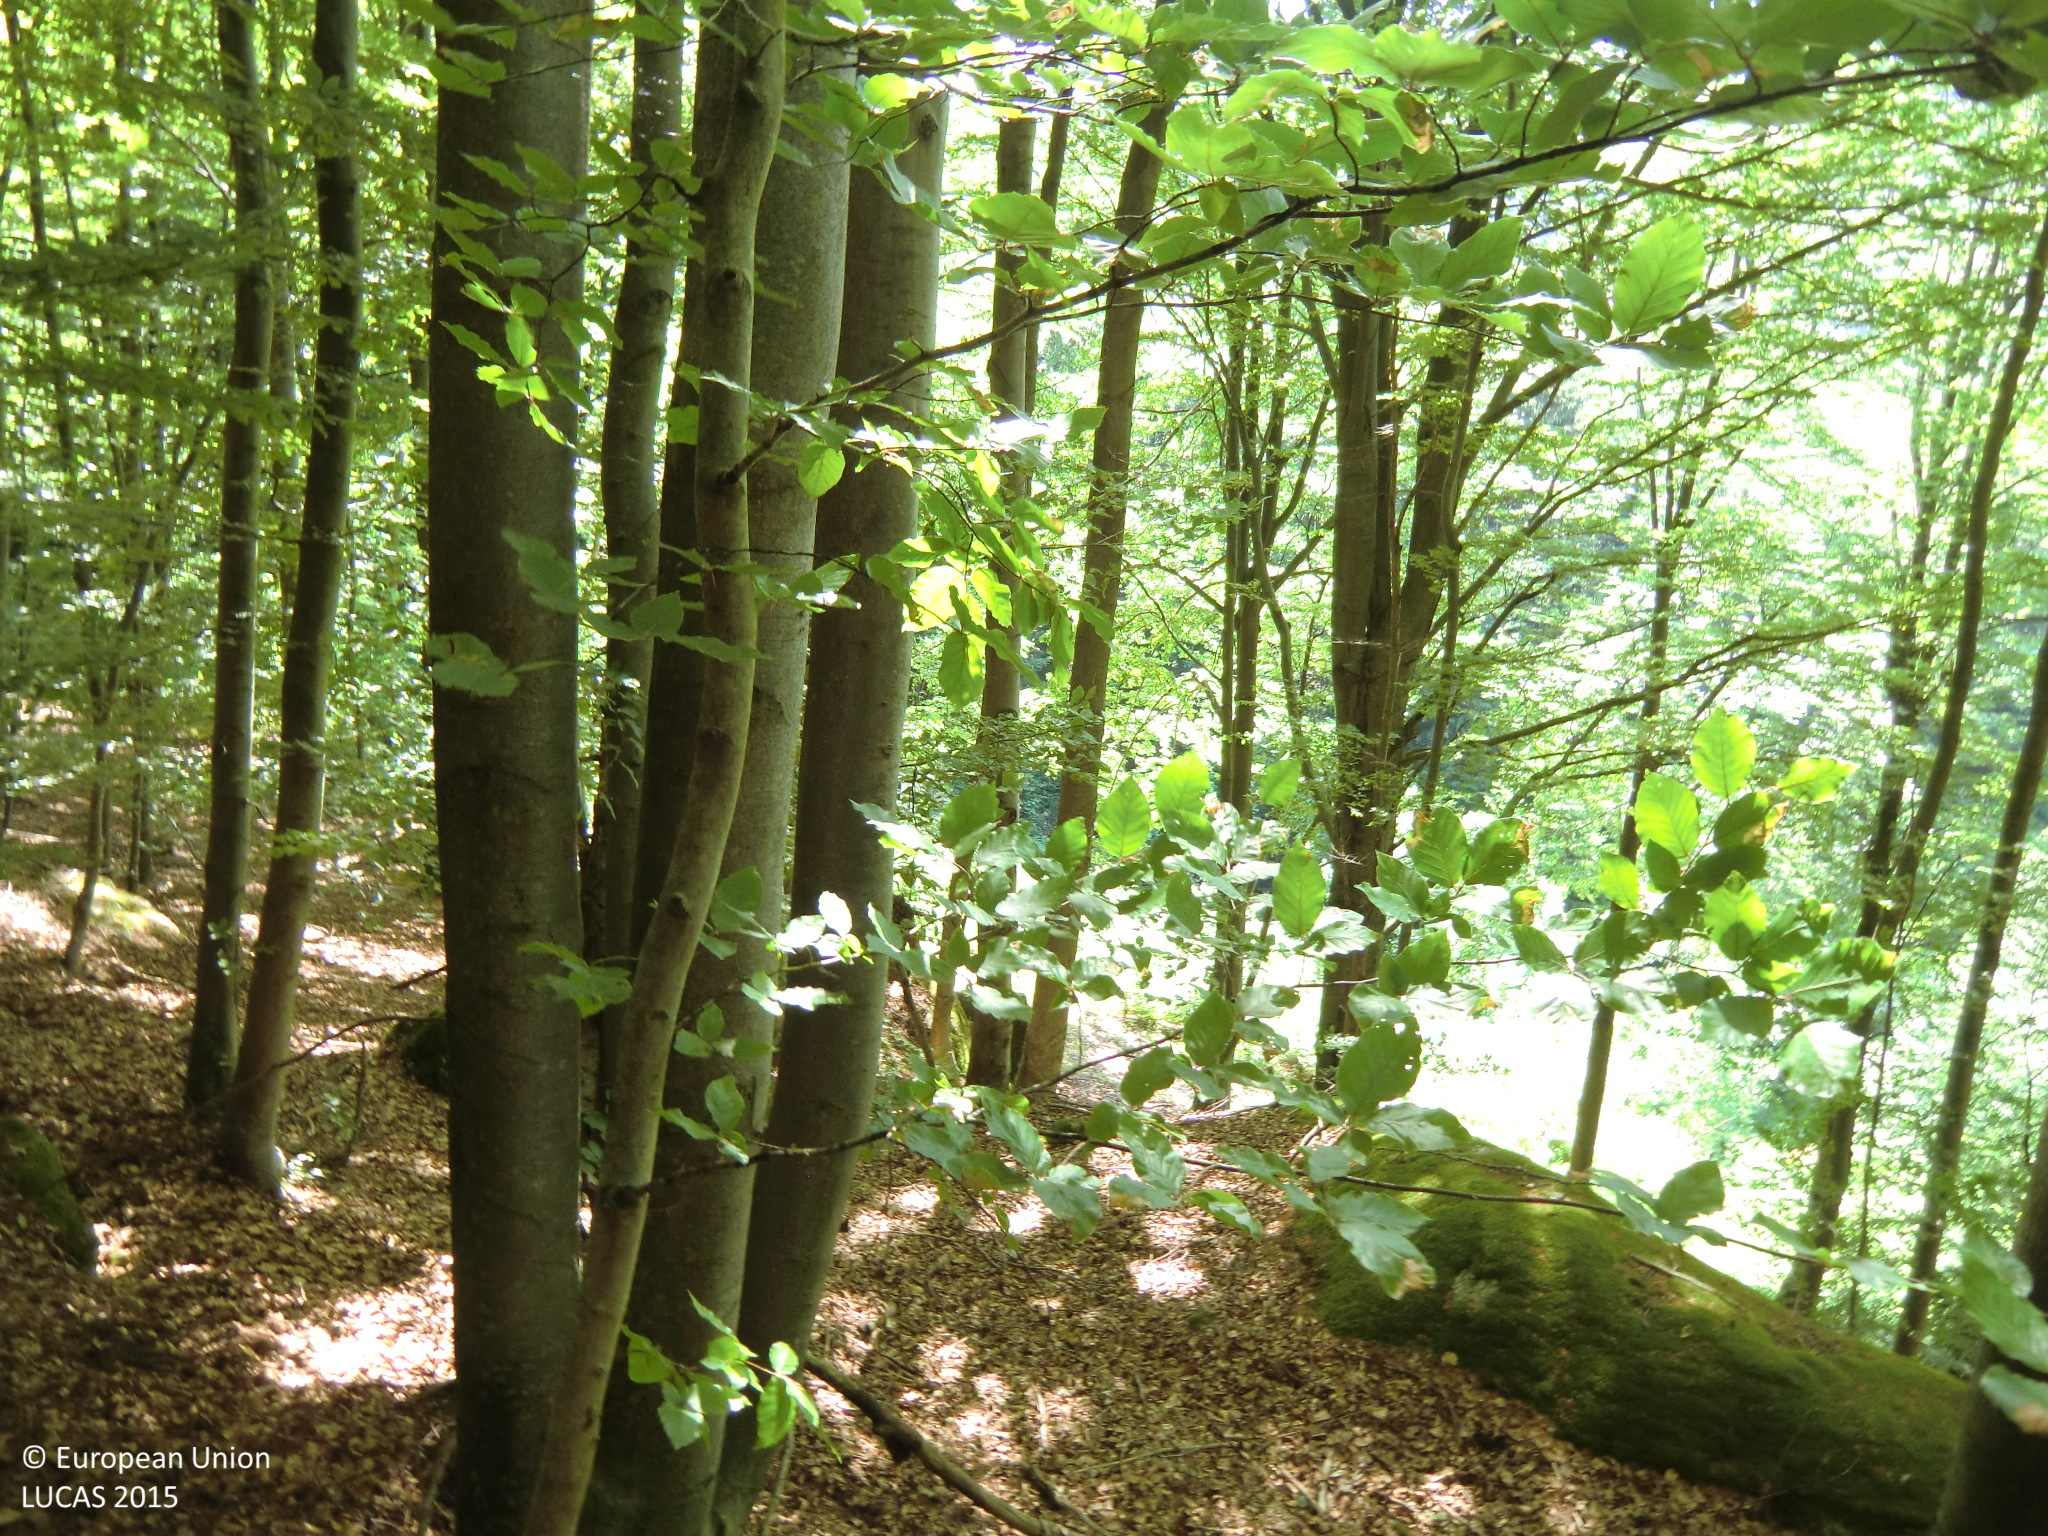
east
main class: Woodland
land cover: Broadleaved woodland
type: hemiboreal forest and nemoral coniferous forest and mixed broadleaved-coniferous forest
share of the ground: > 75 %
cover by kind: broadleaved forest trees 80 %, unconsolidated bare surface 15 %, lichens and mosses 5 %
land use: Forestry
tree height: > 5 m
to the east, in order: Broadleaved woodland; Tracks; Broadleaved woodland; Rivers and streams; Broadleaved woodland; Tracks; Spruce dominated coniferous woodland
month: June
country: AT
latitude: 48.3083
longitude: 15.0035
